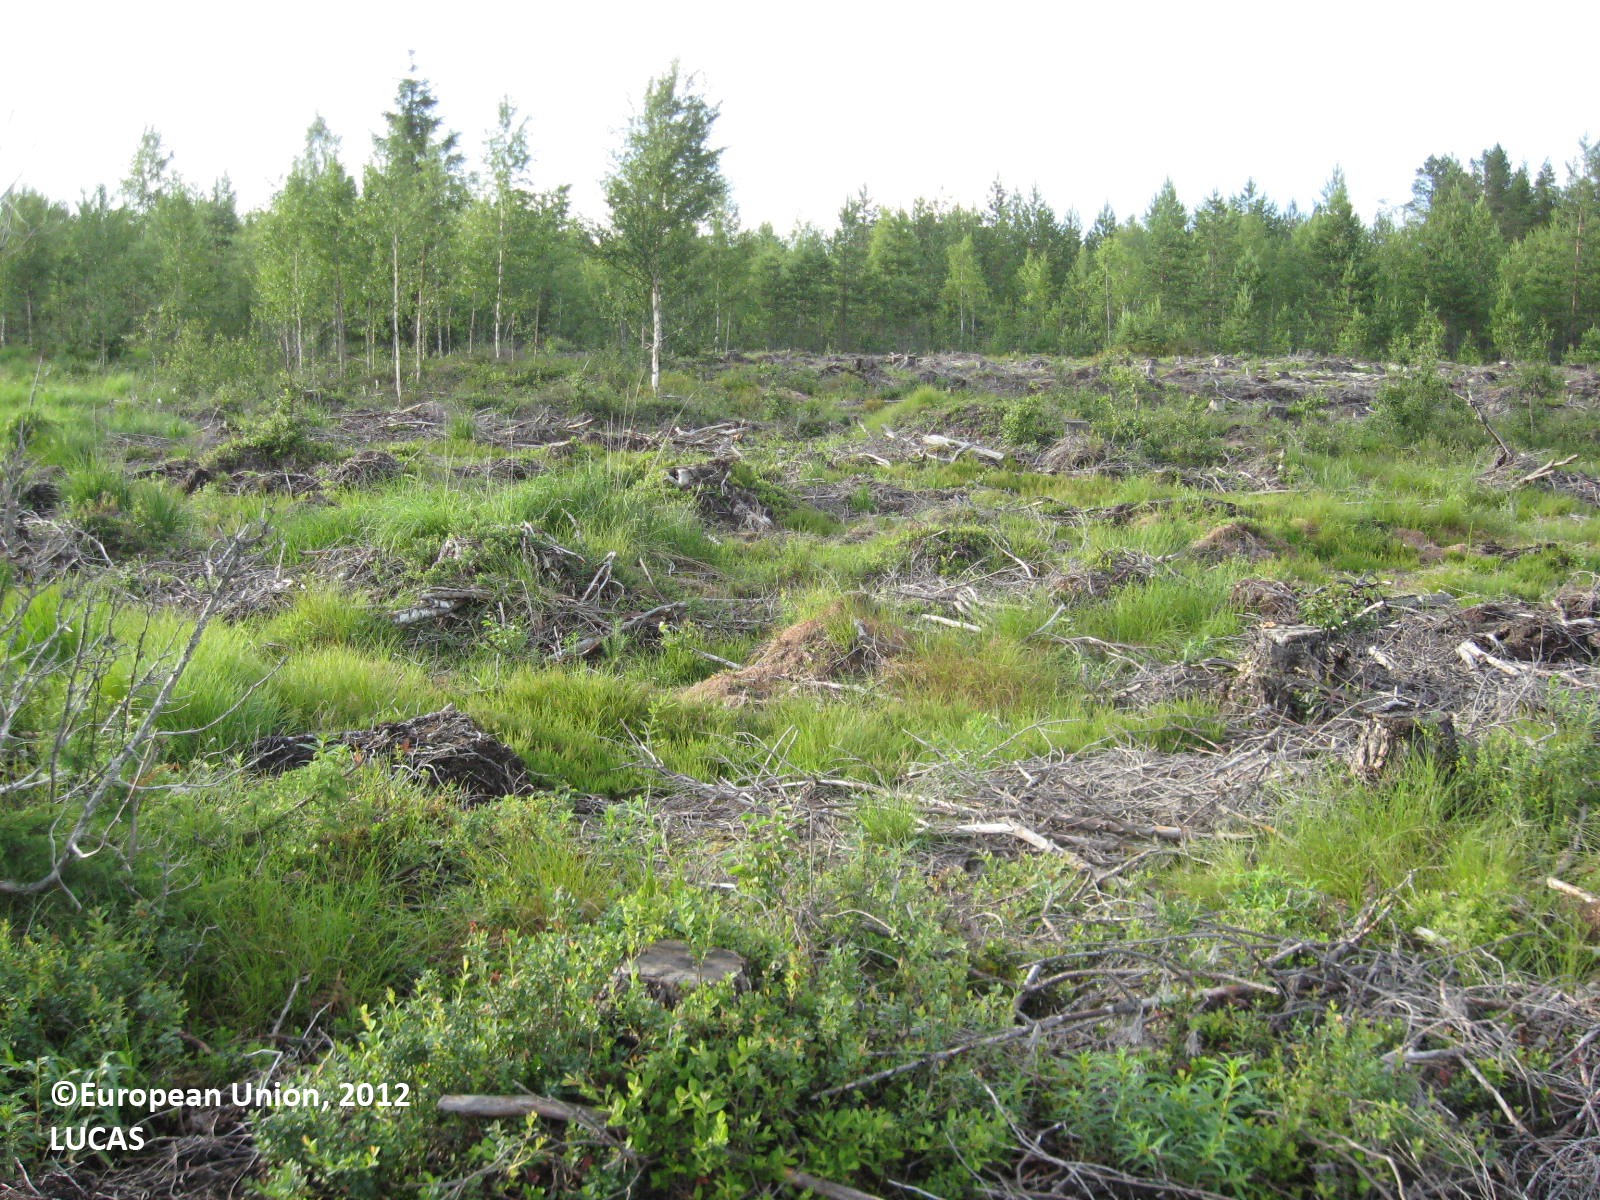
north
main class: Grassland
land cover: Grassland with sparse tree/shrub cover
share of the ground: 50 - 75 %
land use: Forestry
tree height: < 5 m
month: July
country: FI
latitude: 62.3713
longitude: 22.4069
